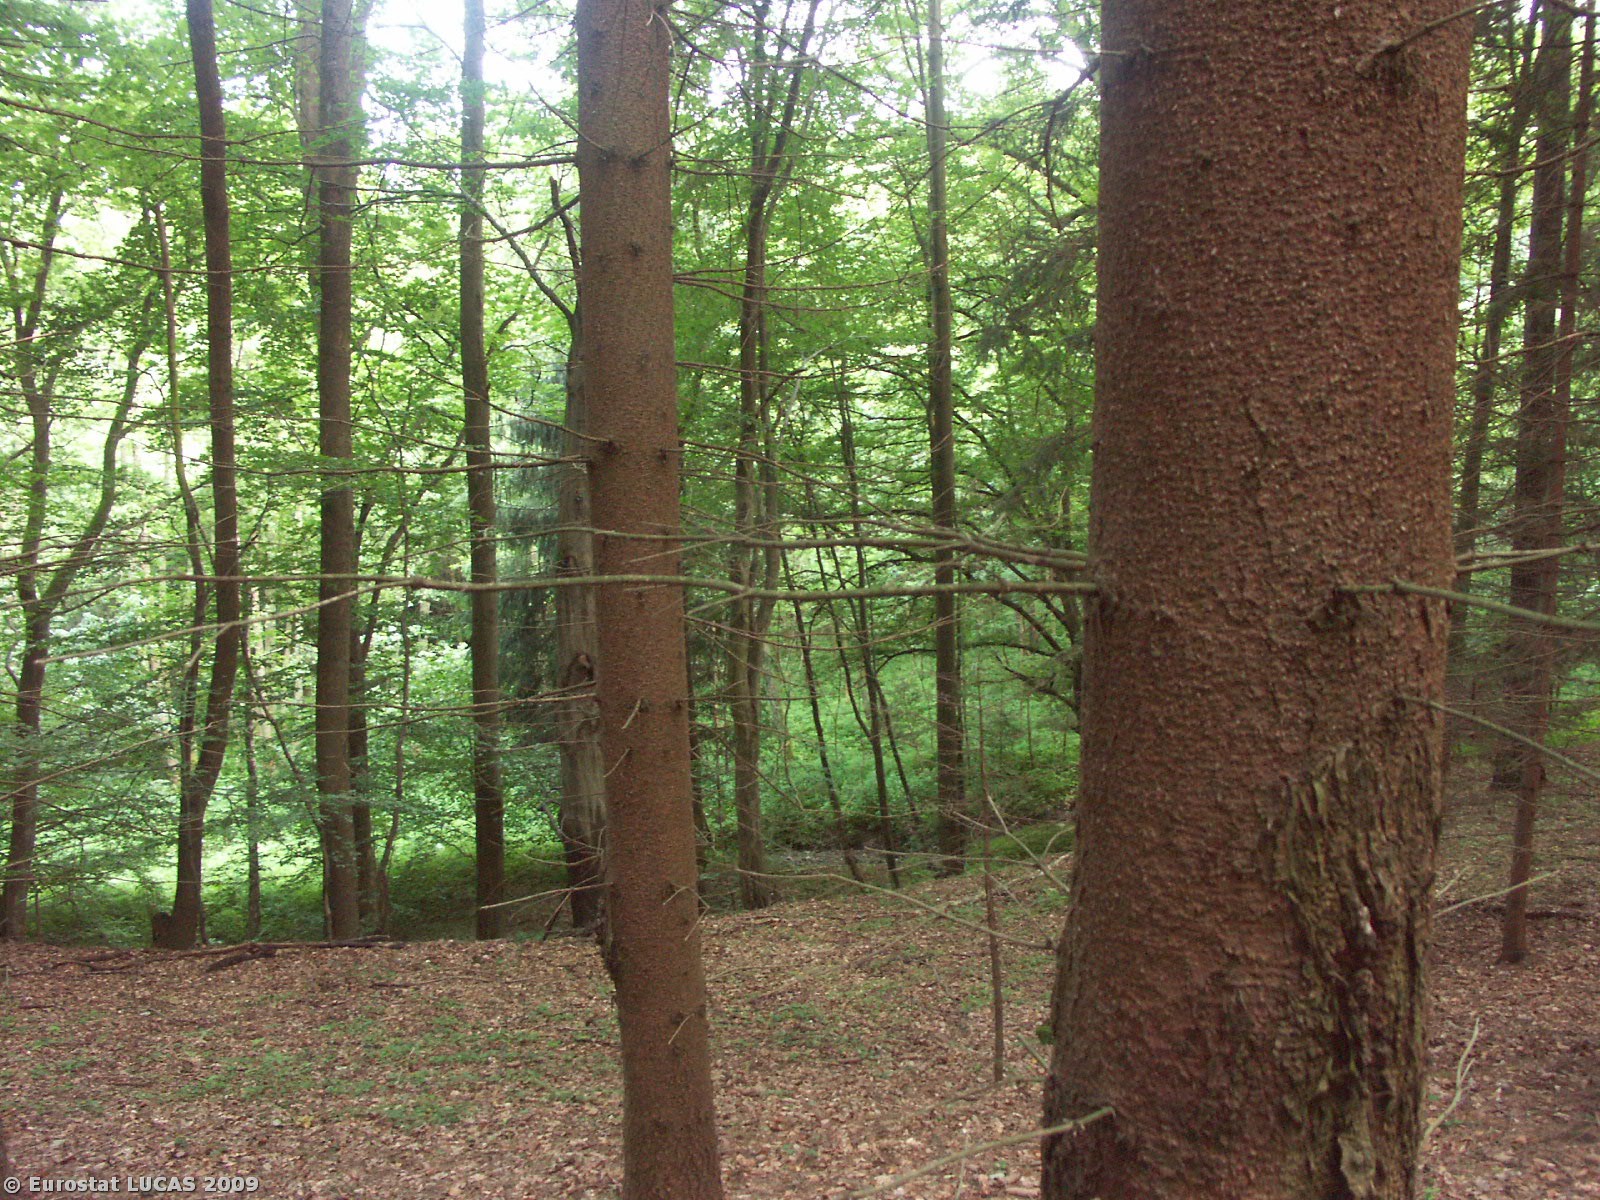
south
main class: Woodland
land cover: Coniferous woodland
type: hemiboreal forest and nemoral coniferous forest and mixed broadleaved-coniferous forest
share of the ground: > 75 %
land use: Forestry
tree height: > 5 m
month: June
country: CZ
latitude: 49.9267
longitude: 17.1005
